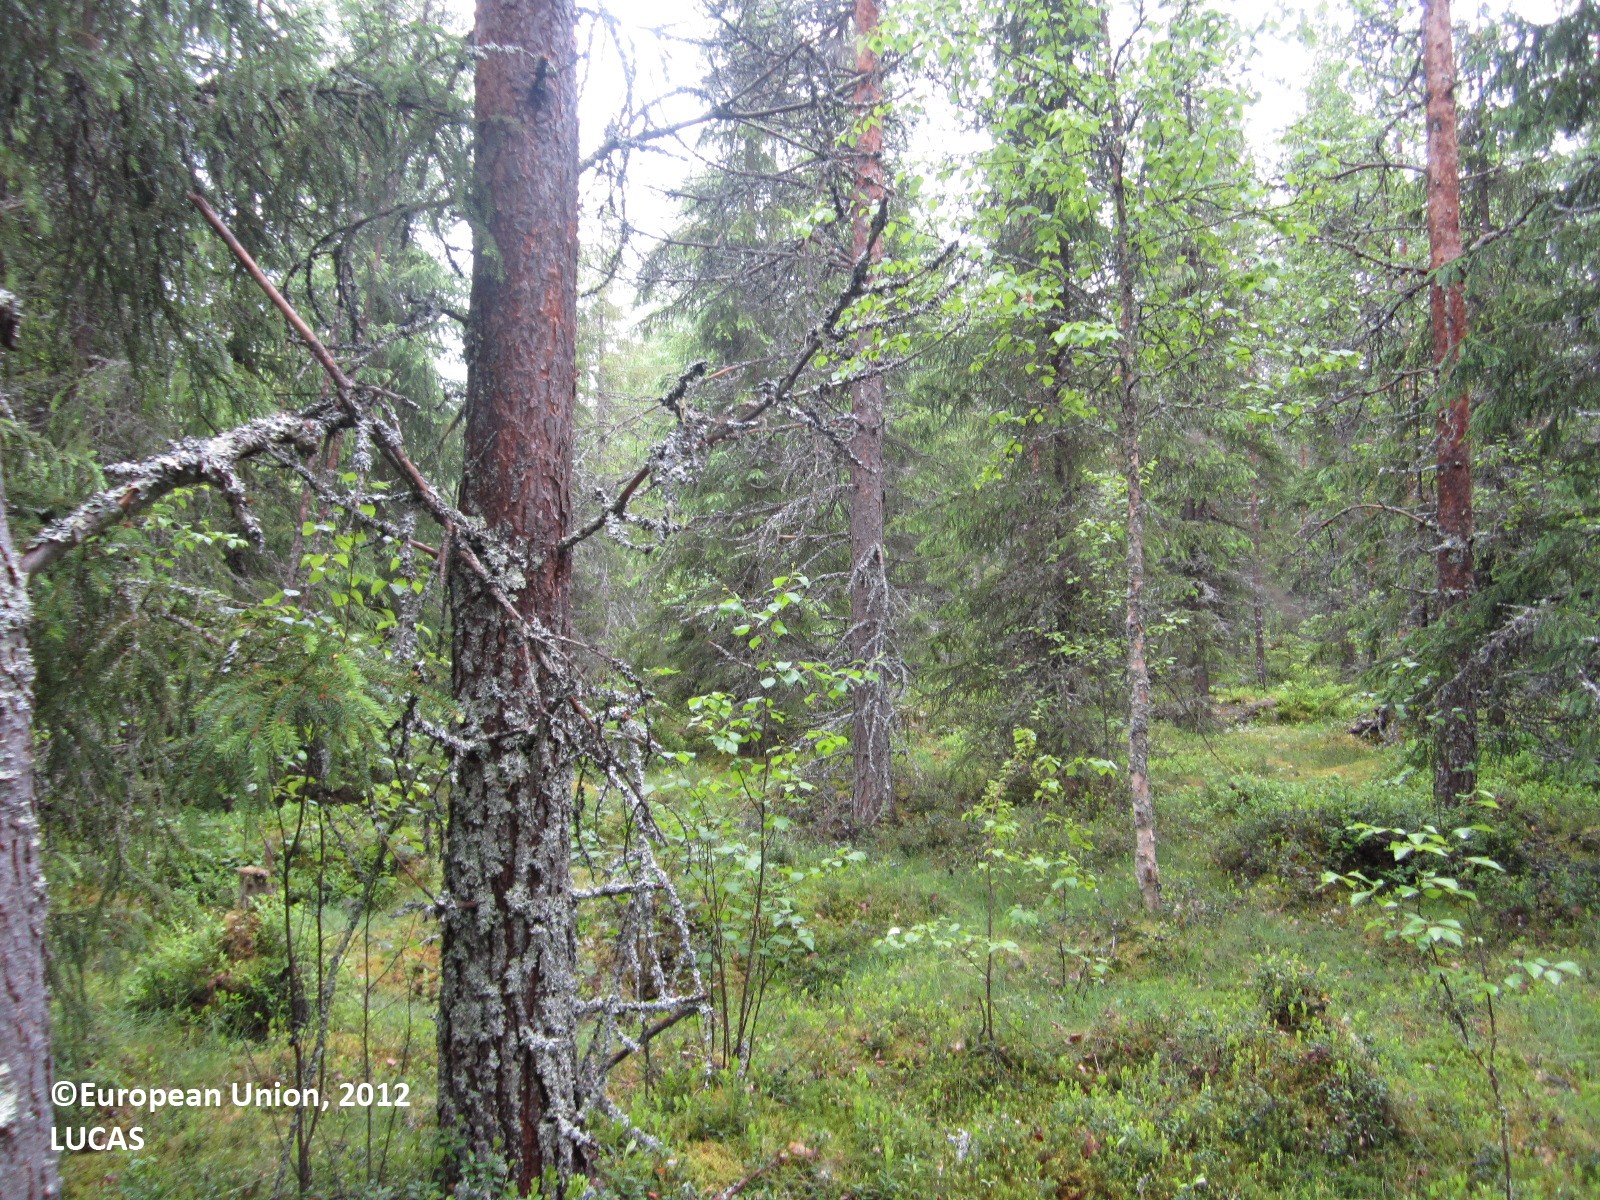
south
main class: Woodland
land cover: Other mixed woodland
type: boreal forest
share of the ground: > 75 %
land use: Forestry
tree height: > 5 m
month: June
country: FI
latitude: 64.5887
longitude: 29.2289
